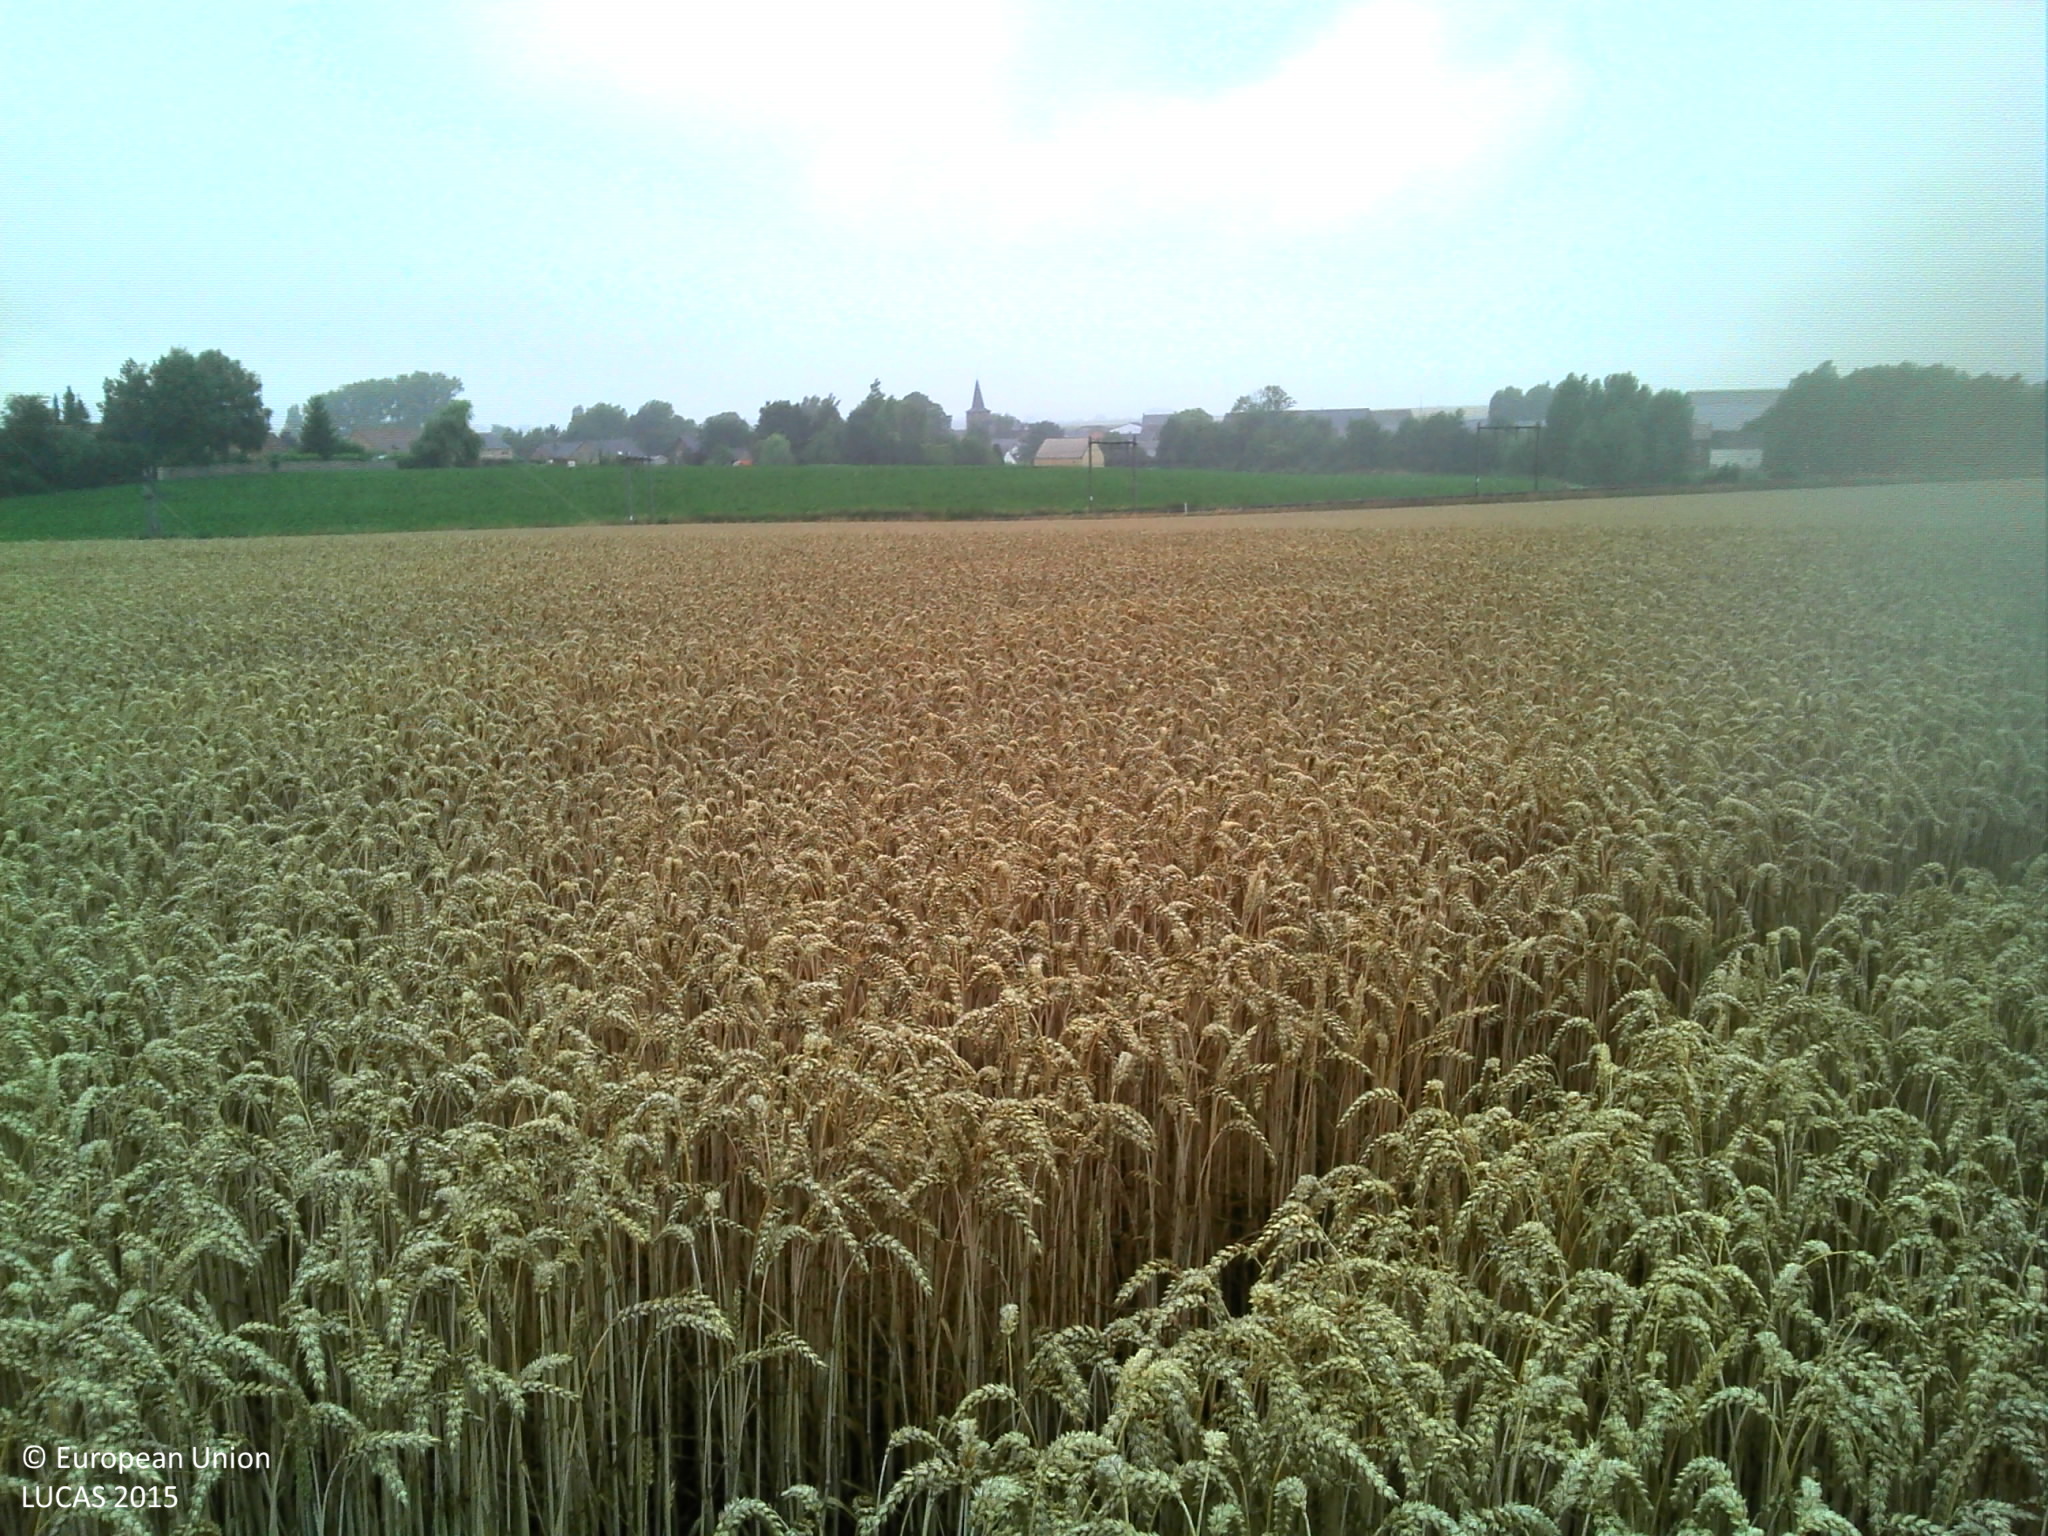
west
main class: Cropland
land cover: Common wheat
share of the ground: > 75 %
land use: Agriculture (excluding fallow land and kitchen gardens)
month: July
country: BE
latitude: 50.5233
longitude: 4.5655
